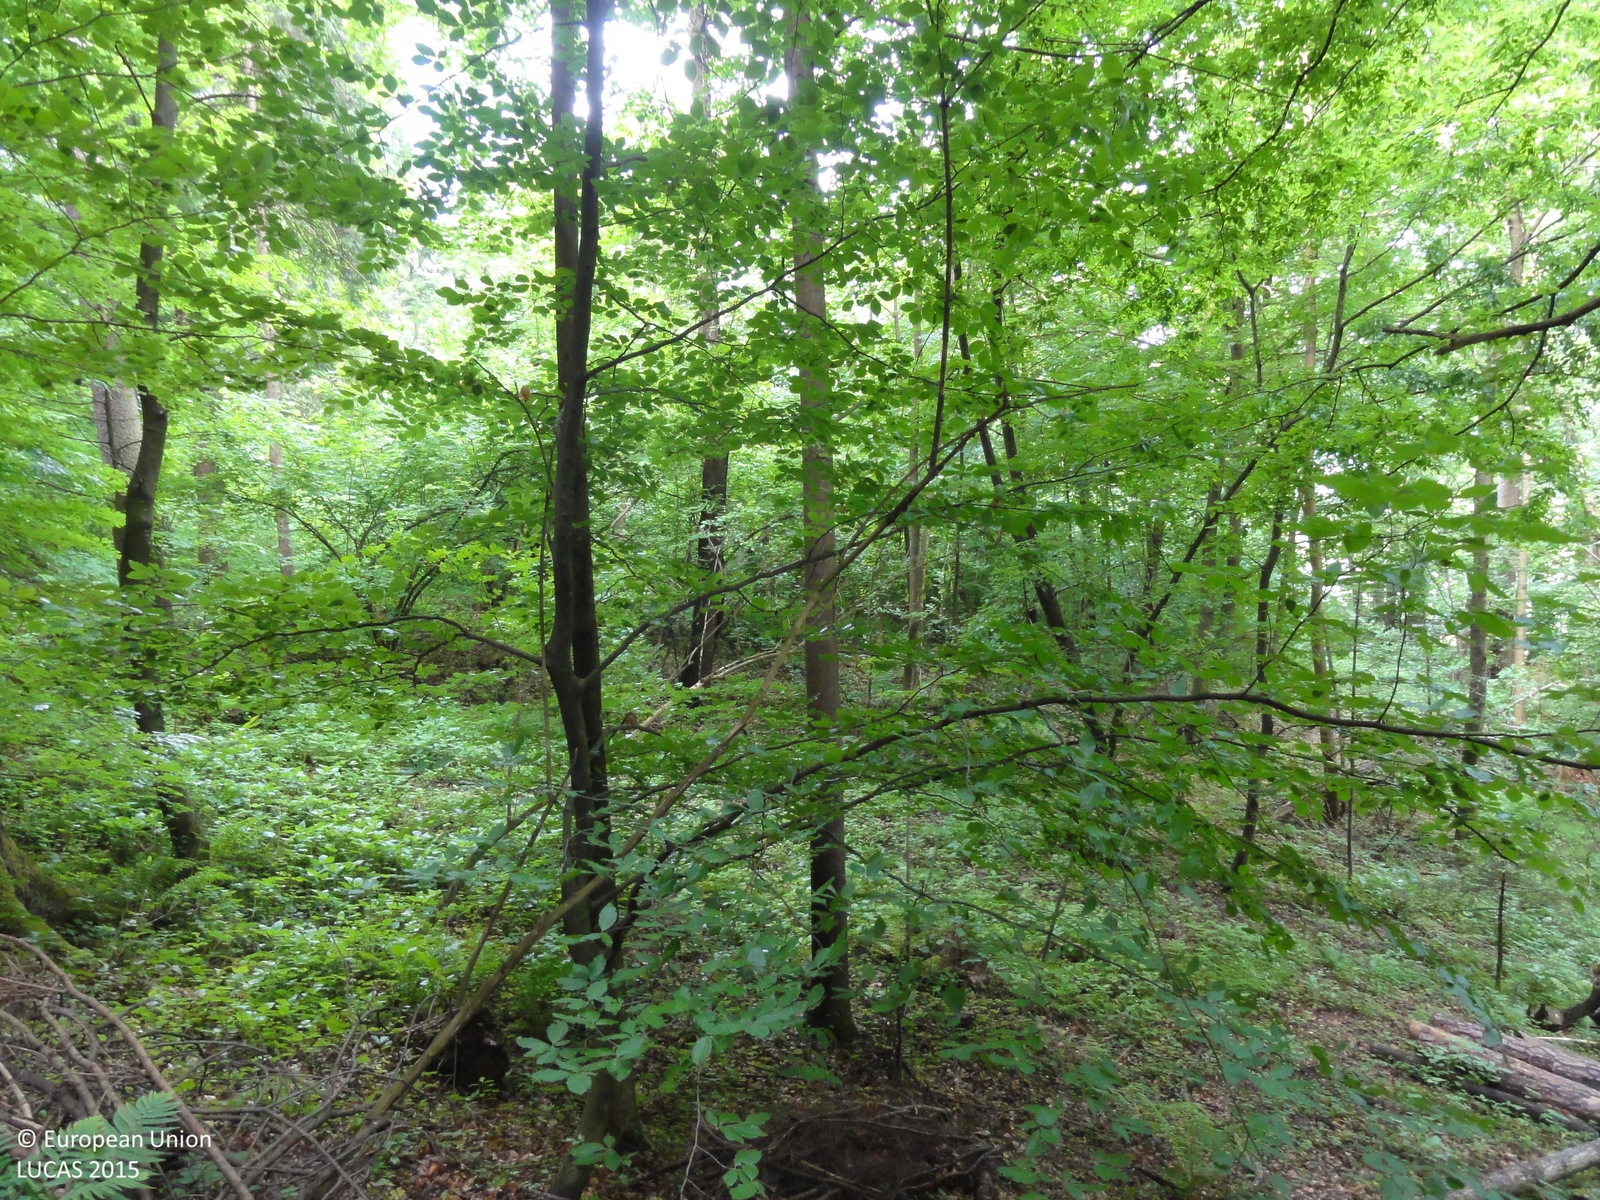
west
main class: Woodland
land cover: Spruce dominated mixed woodland
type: beech forest
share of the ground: > 75 %
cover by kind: coniferous forest trees 60 %, broadleaved forest trees 40 %
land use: Forestry
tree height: > 5 m
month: May
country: SI
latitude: 46.5505
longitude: 15.5419
